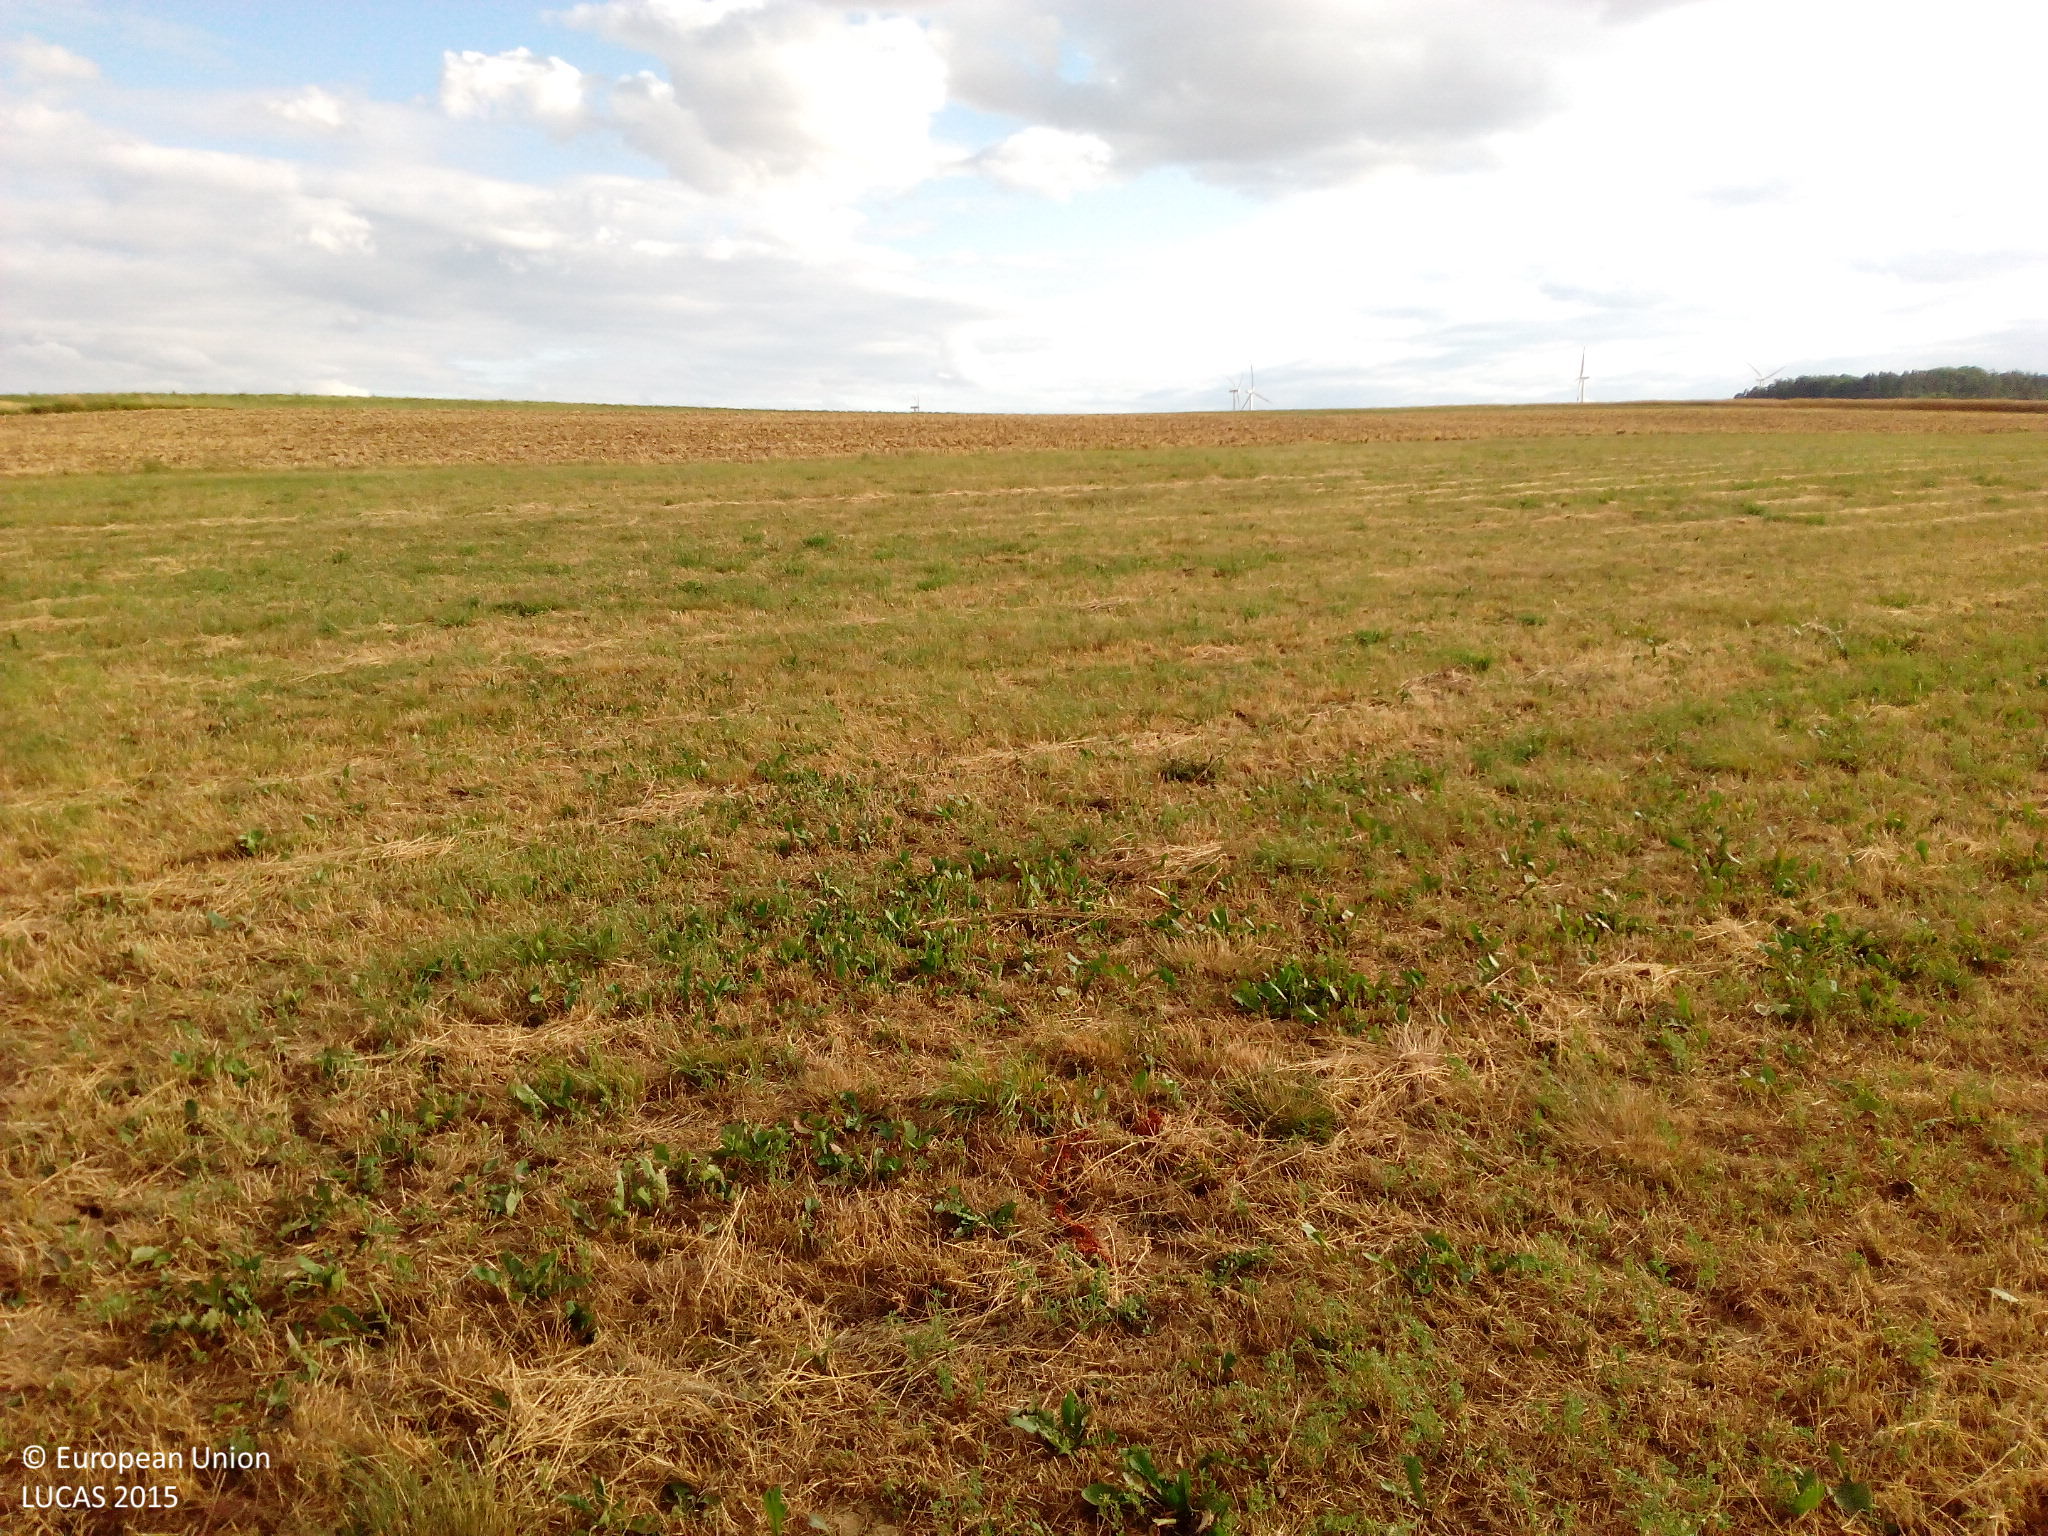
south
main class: Grassland
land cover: Grassland without tree/shrub cover
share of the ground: > 75 %
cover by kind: herbaceous plants 85 %, unconsolidated bare surface 15 %
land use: Agriculture (excluding fallow land and kitchen gardens)
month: July
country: DE
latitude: 49.7166
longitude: 9.9030
